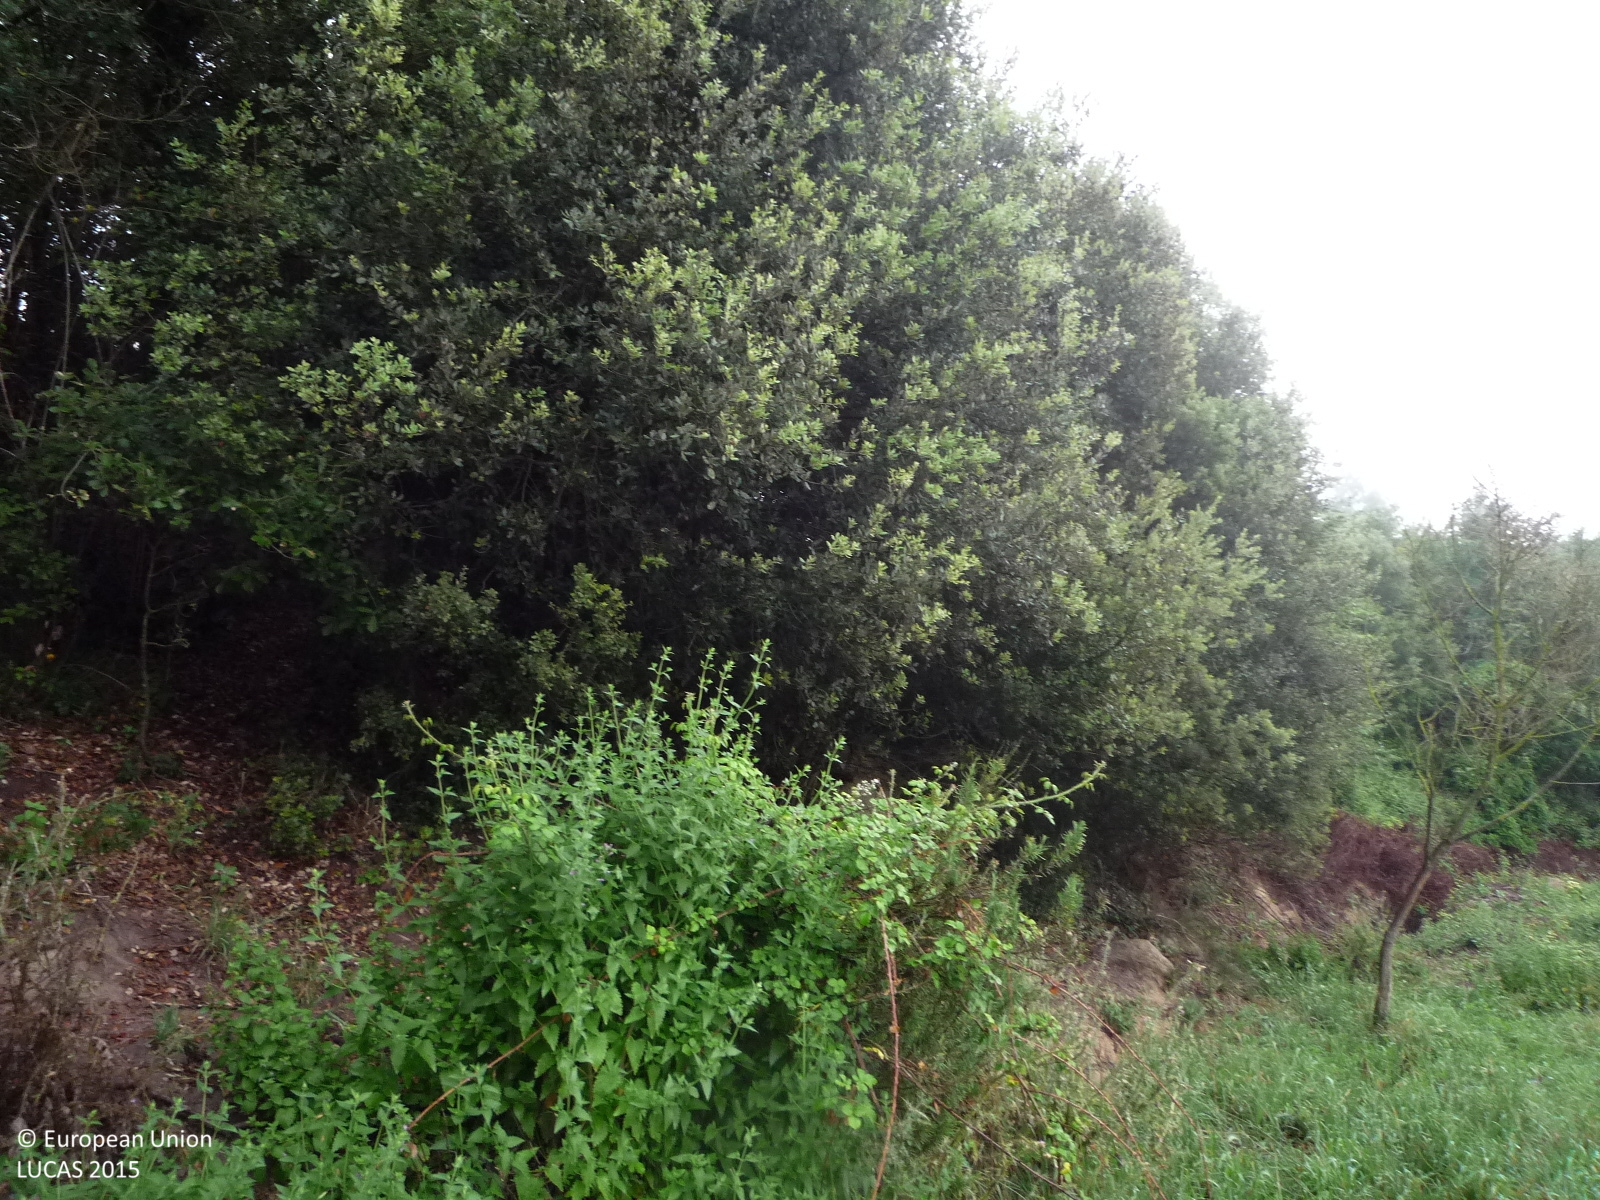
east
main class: Grassland
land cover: Grassland without tree/shrub cover
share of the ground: > 75 %
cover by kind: herbaceous plants 100 %
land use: Agriculture (excluding fallow land and kitchen gardens)
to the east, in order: Grassland without tree/shrub cover; Broadleaved woodland; Rocks and stones; Tracks; Shrubland with sparse tree cover; Grassland without tree/shrub cover; Shrubland with sparse tree cover; Grassland without tree/shrub cover; Fences; Tracks; Grass margins; Fences; Grass margins; Tracks; Broadleaved woodland; Grassland without tree/shrub cover; Broadleaved woodland; Tracks; Broadleaved woodland; Tracks; Broadleaved woodland
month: June
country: ES
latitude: 42.0254
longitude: 1.9579
